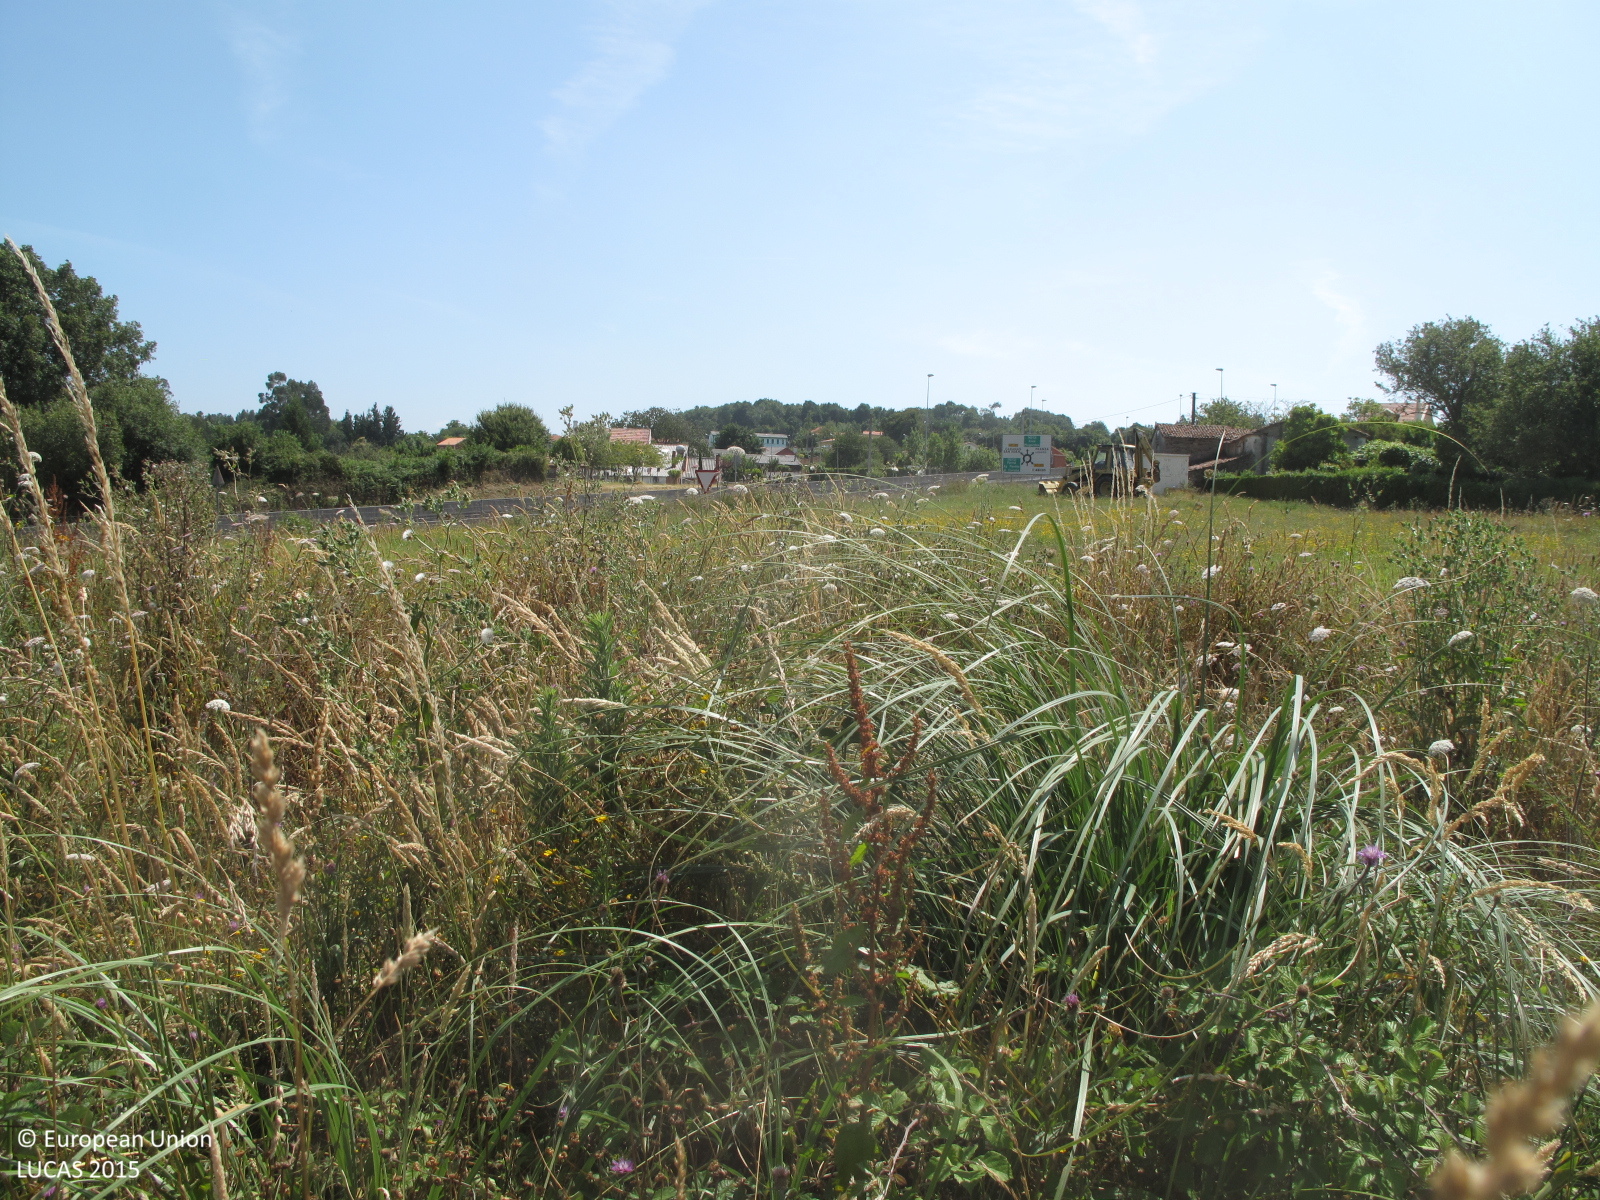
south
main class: Shrubland
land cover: Shrubland without tree cover
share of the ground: 25 - 50 %
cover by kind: herbaceous plants 70 %, shrubs 30 %
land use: Abandoned areas
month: July
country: ES
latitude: 43.4435
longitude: -8.2030
